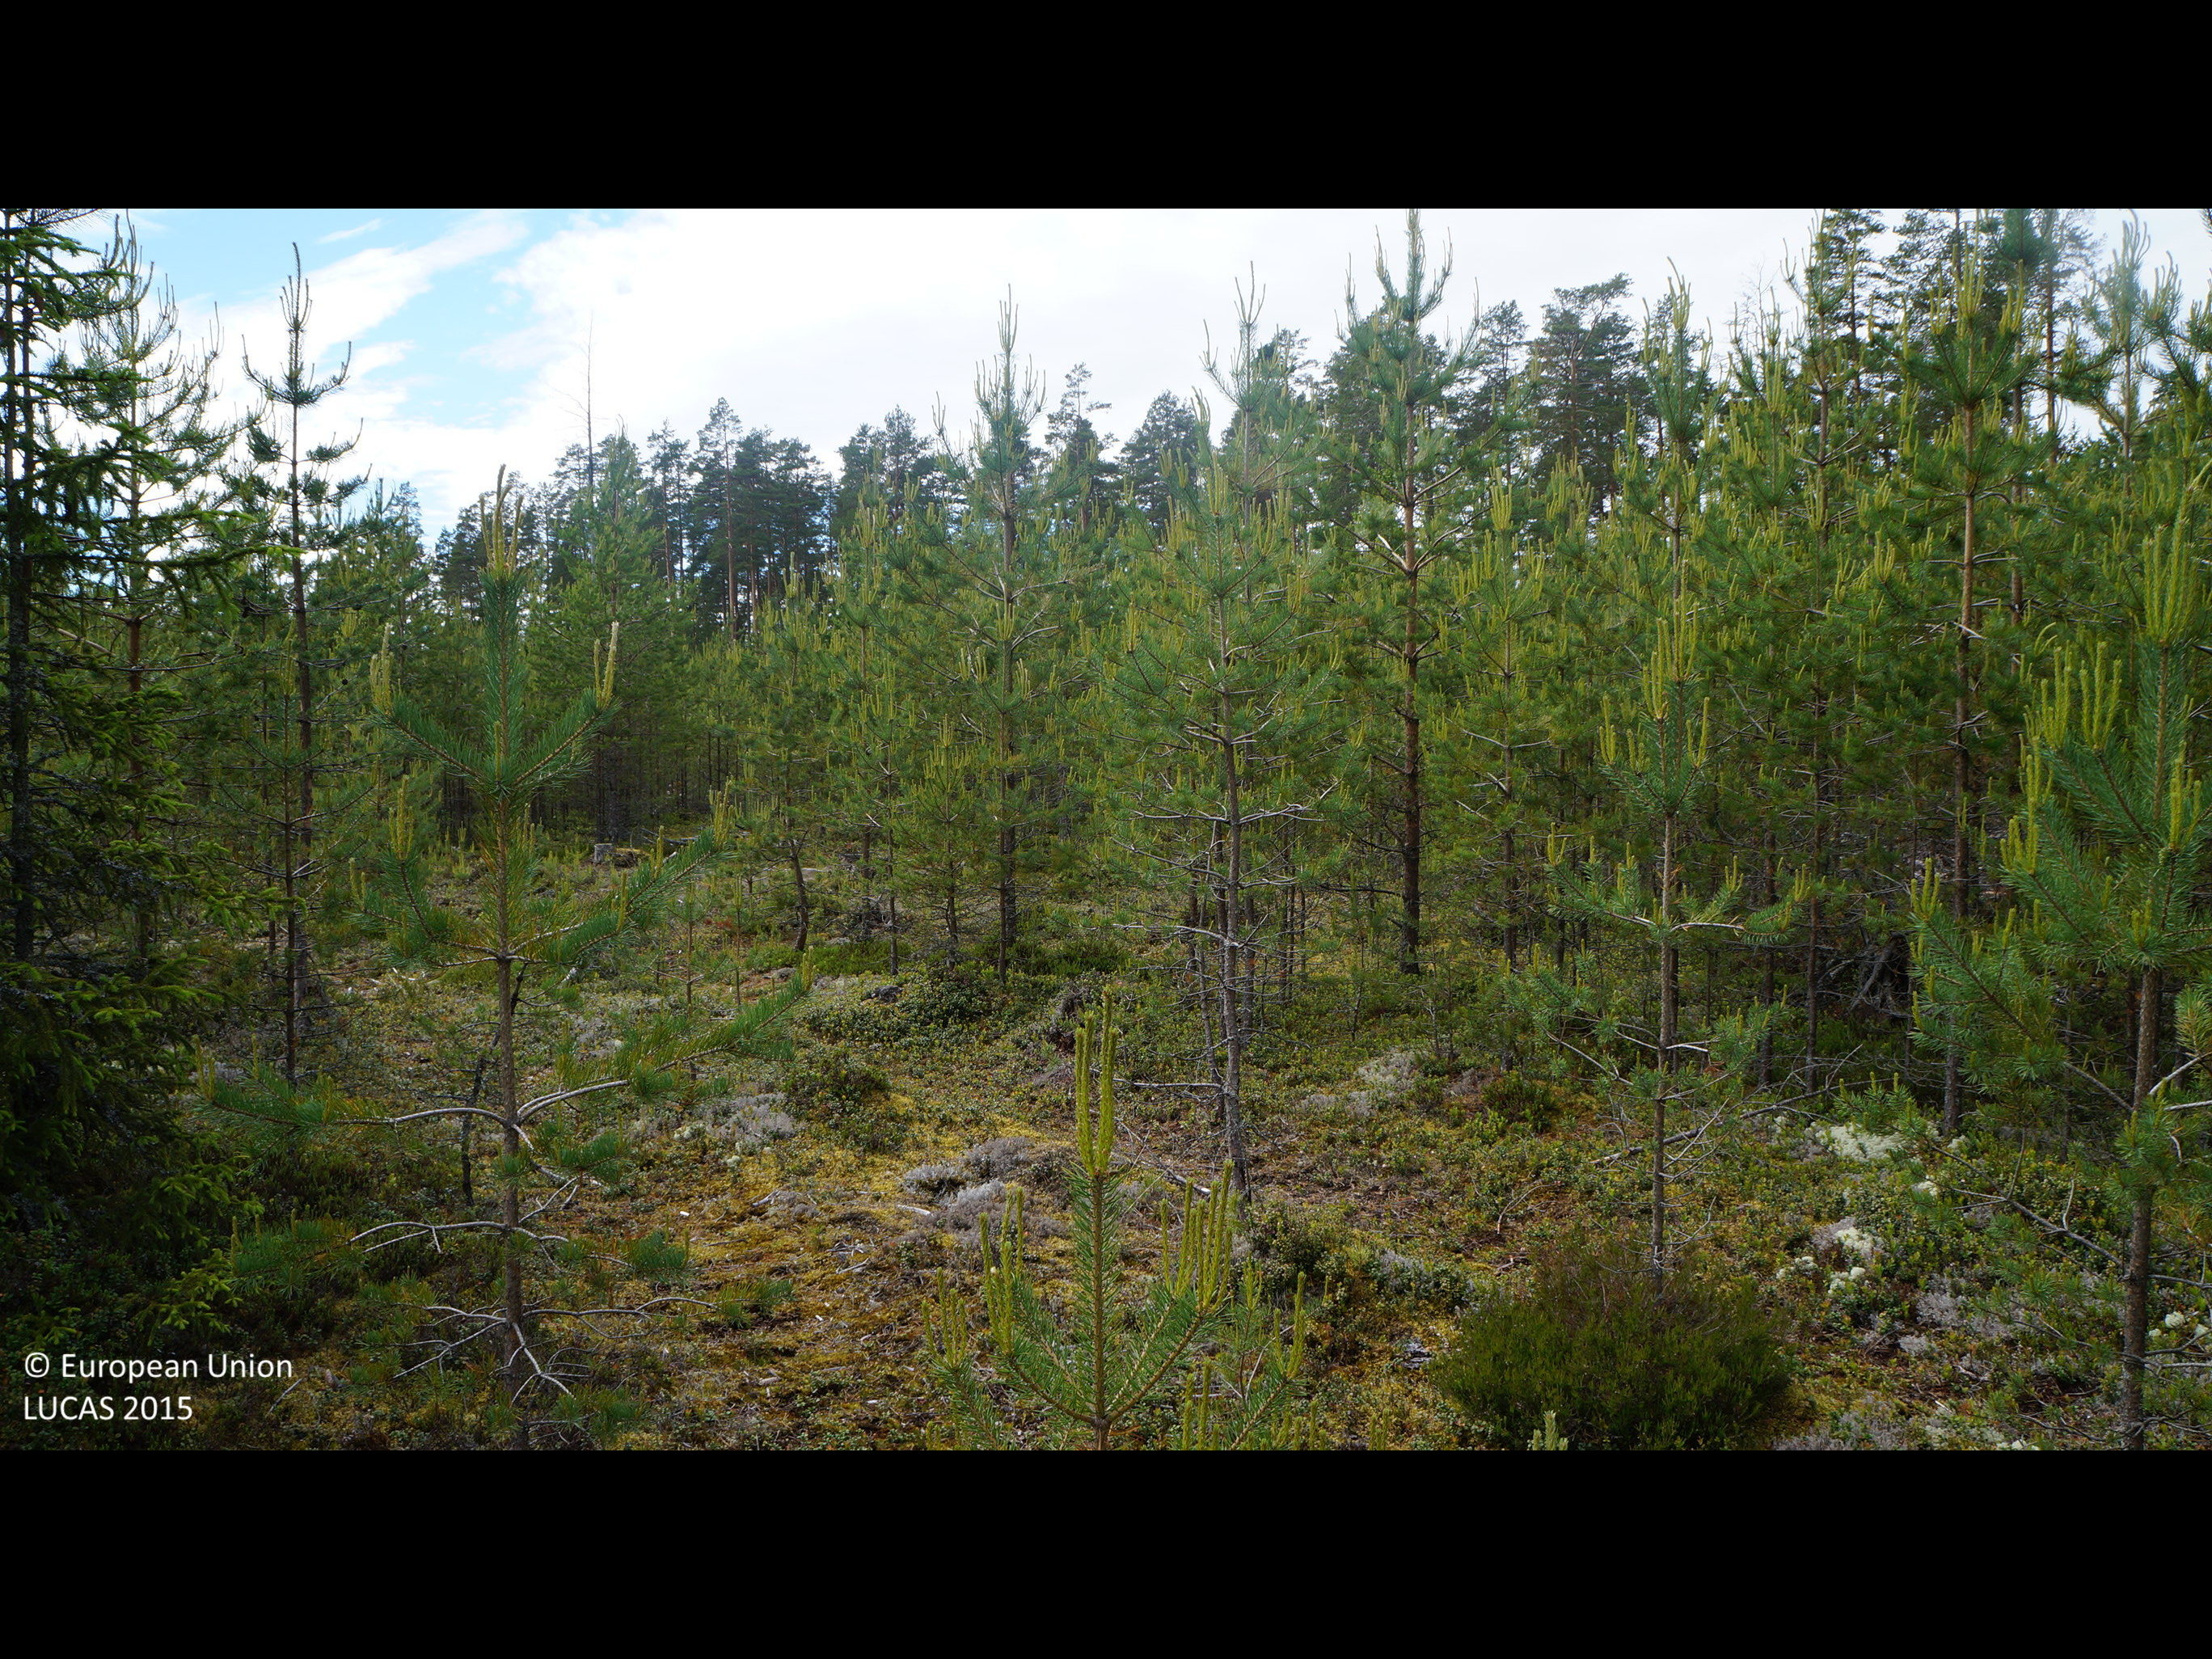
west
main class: Woodland
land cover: Pine dominated coniferous woodland
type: boreal forest
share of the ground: 25 - 50 %
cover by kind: coniferous forest trees 40 %, shrubs 40 %, lichens and mosses 20 %
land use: Forestry
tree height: > 5 m
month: June
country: FI
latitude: 63.8036
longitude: 23.0256
